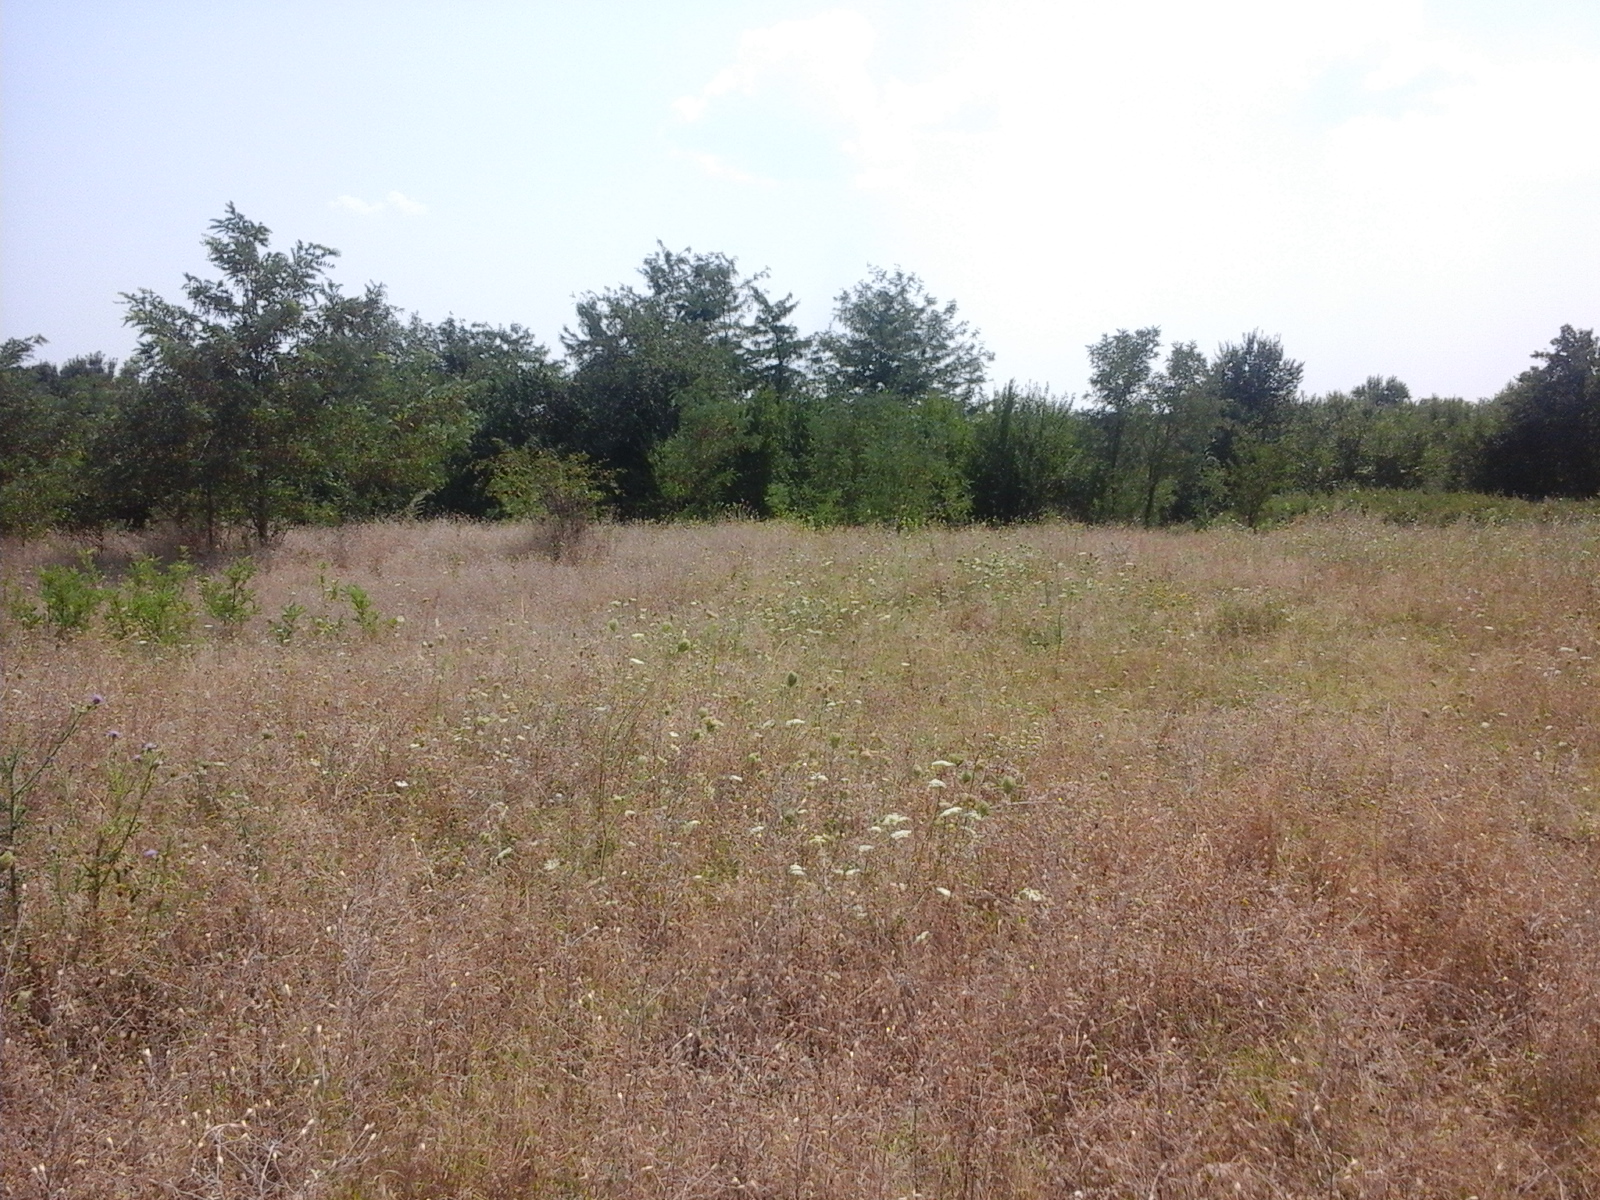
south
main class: Grassland
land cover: Grassland without tree/shrub cover
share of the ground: > 75 %
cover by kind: herbaceous plants 100 %
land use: Agriculture (excluding fallow land and kitchen gardens)
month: August
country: RO
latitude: 44.1975
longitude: 23.4763
